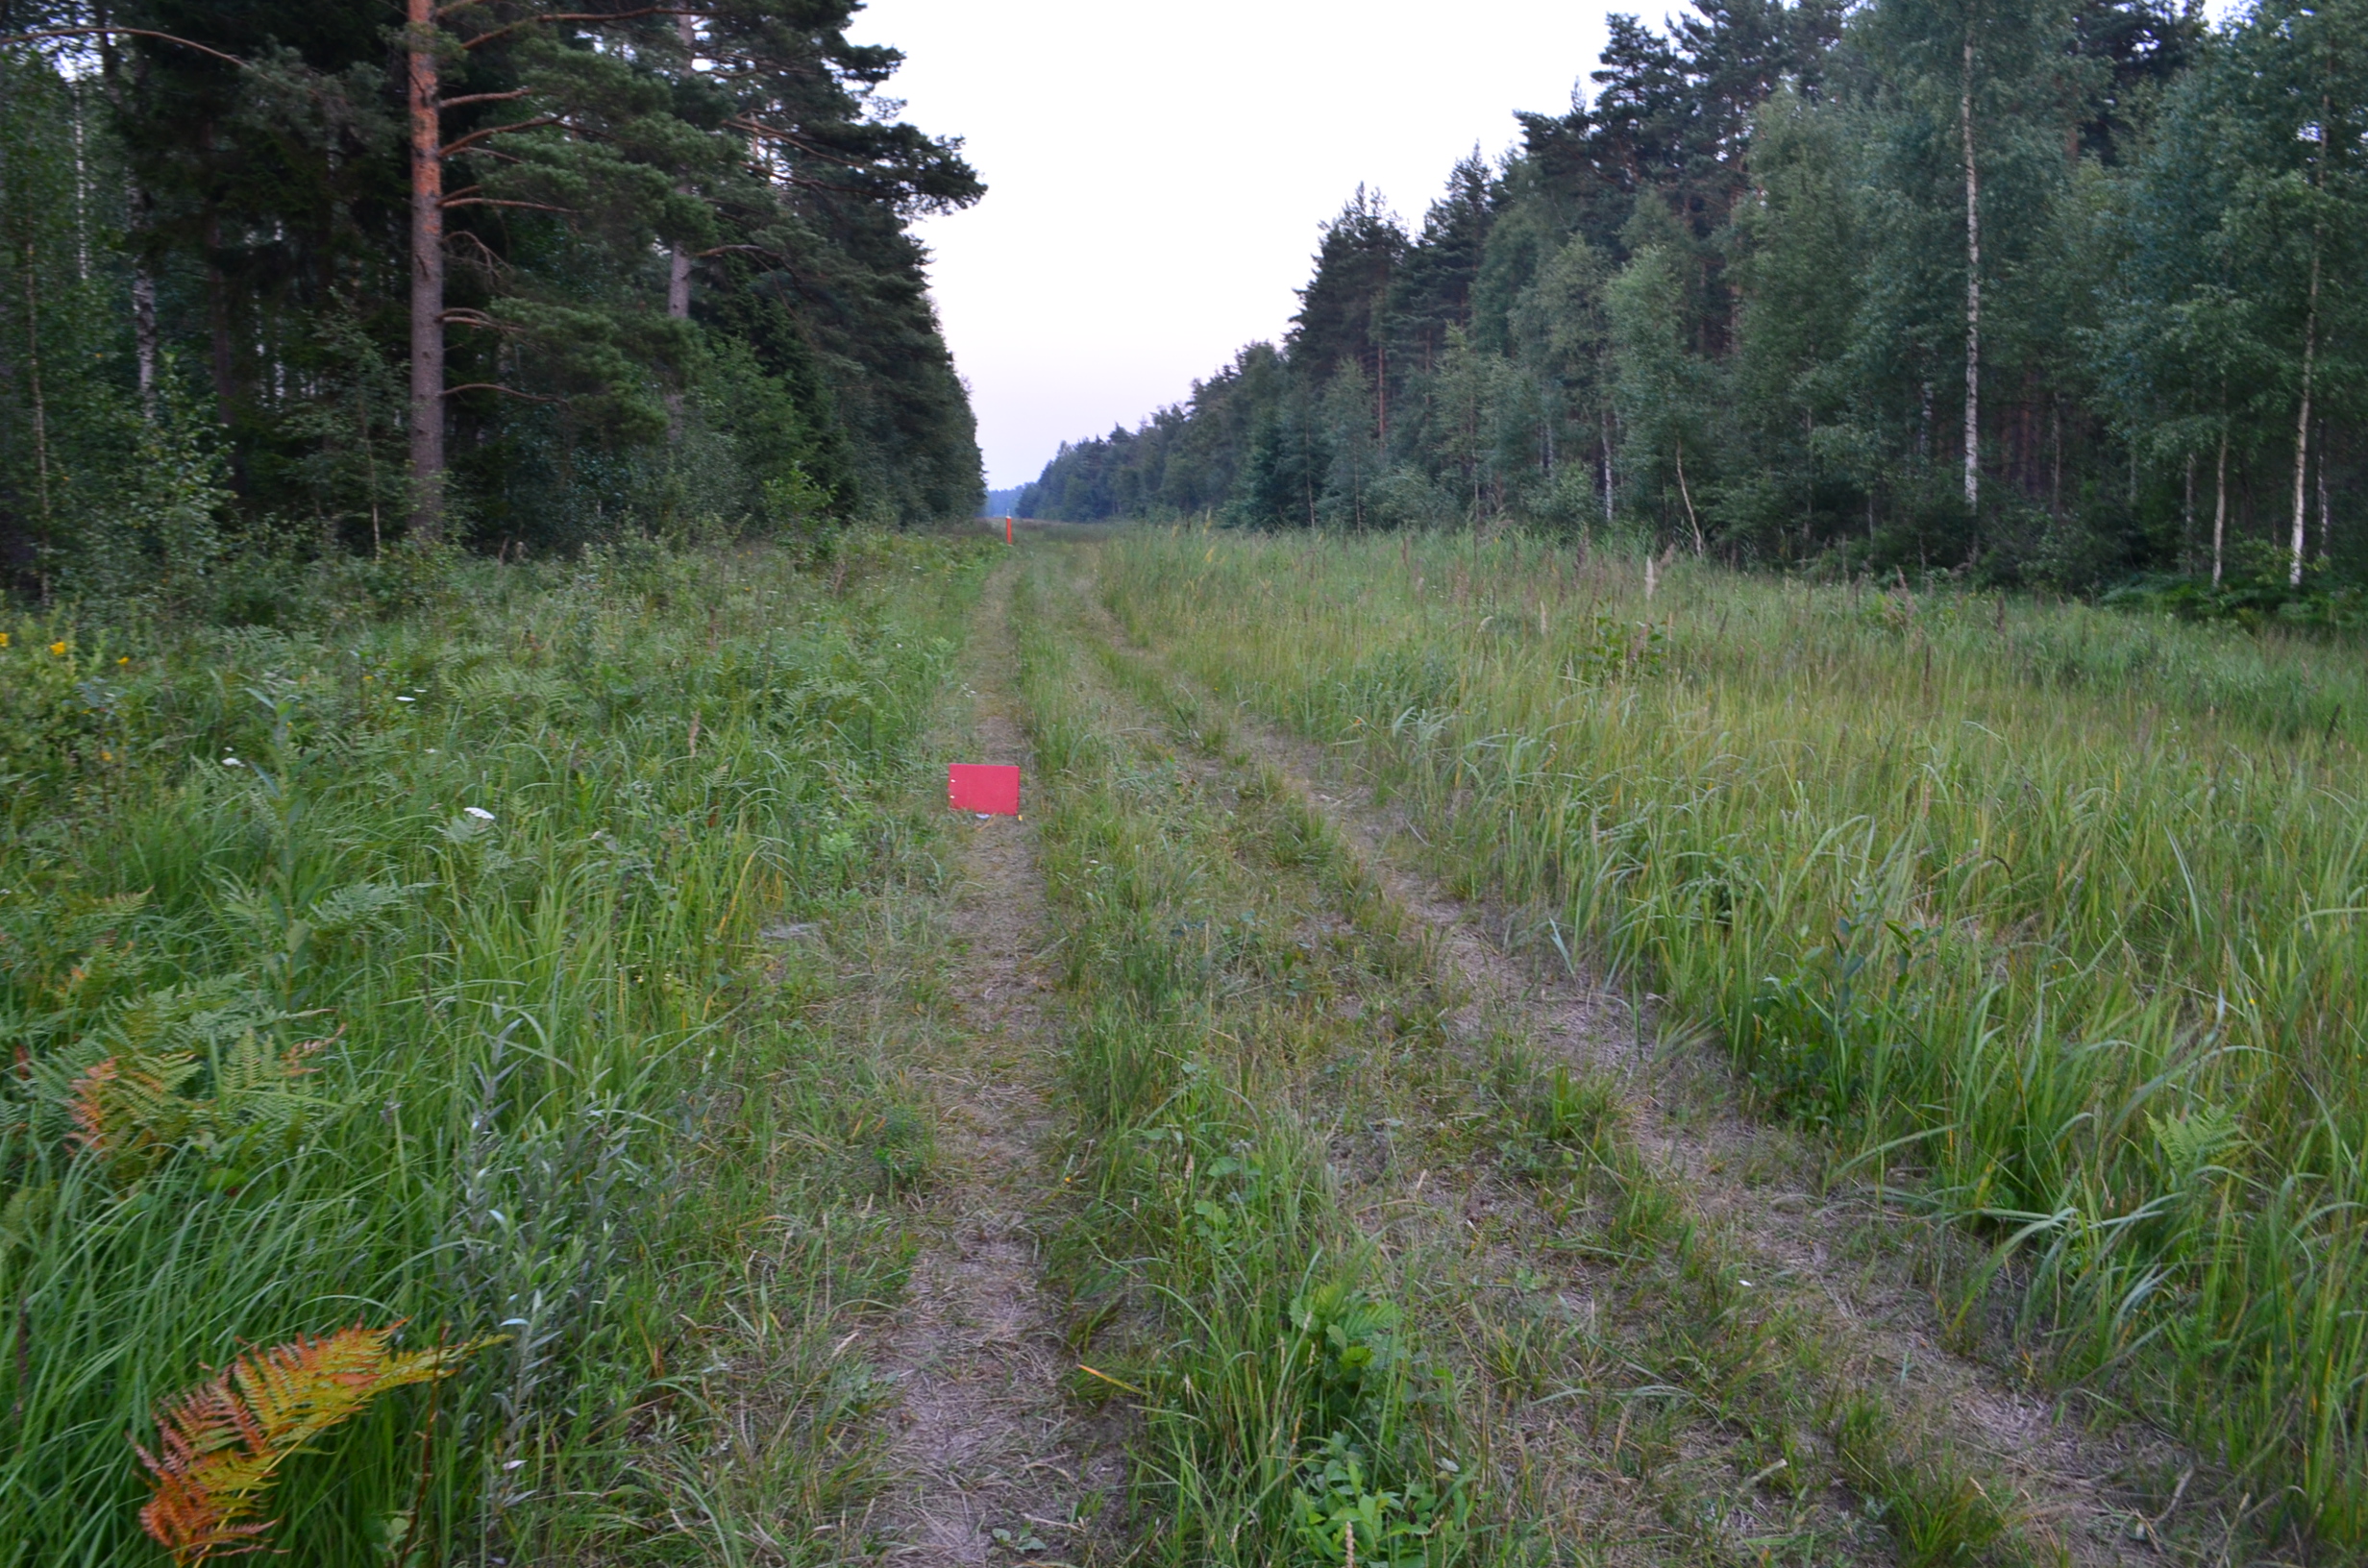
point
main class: Woodland
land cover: Pine dominated mixed woodland
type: hemiboreal forest and nemoral coniferous forest and mixed broadleaved-coniferous forest
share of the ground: > 75 %
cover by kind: broadleaved forest trees 55 %, coniferous forest trees 40 %, herbaceous plants 4 %, shrubs 1 %
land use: Forestry
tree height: > 5 m
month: August
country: LV
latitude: 57.4200
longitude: 21.6460
